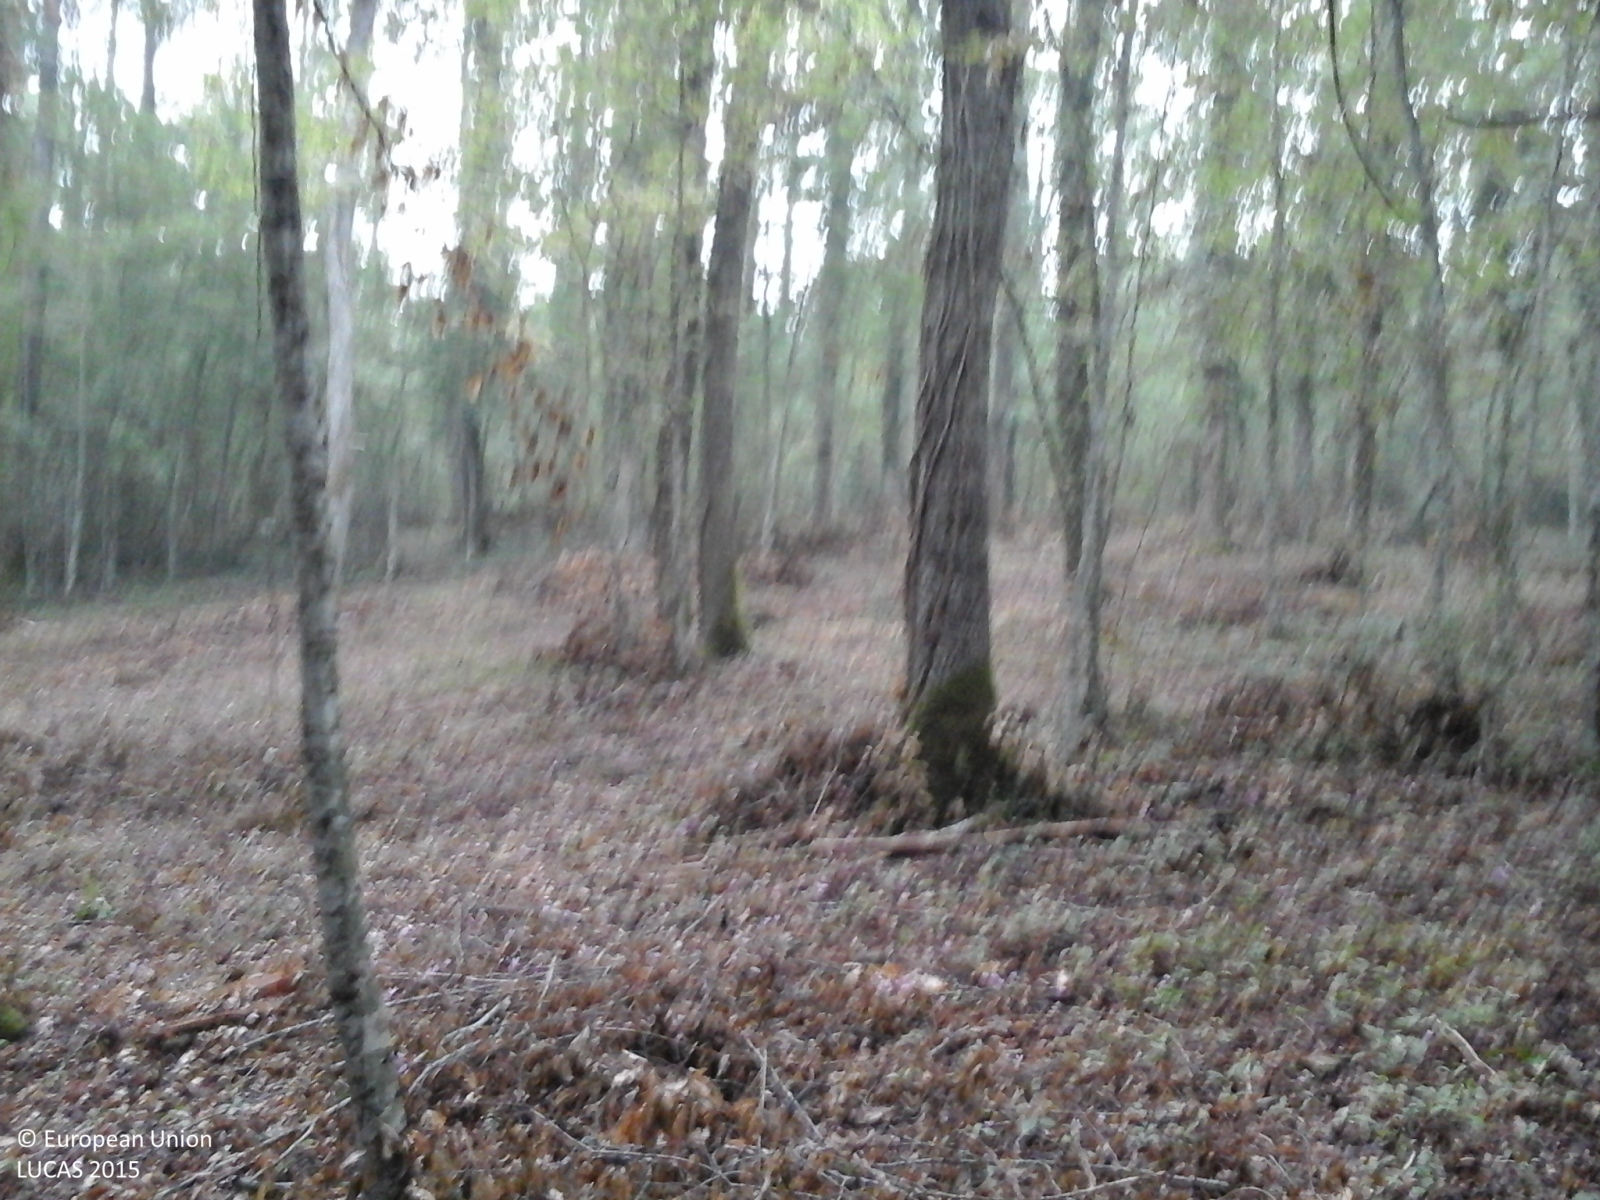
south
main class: Woodland
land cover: Broadleaved woodland
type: thermophilous deciduous forest
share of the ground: > 75 %
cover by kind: broadleaved forest trees 85 %, herbaceous plants 10 %, shrubs 5 %
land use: Forestry
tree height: > 5 m
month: September
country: IT
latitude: 41.7094
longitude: 14.3716
